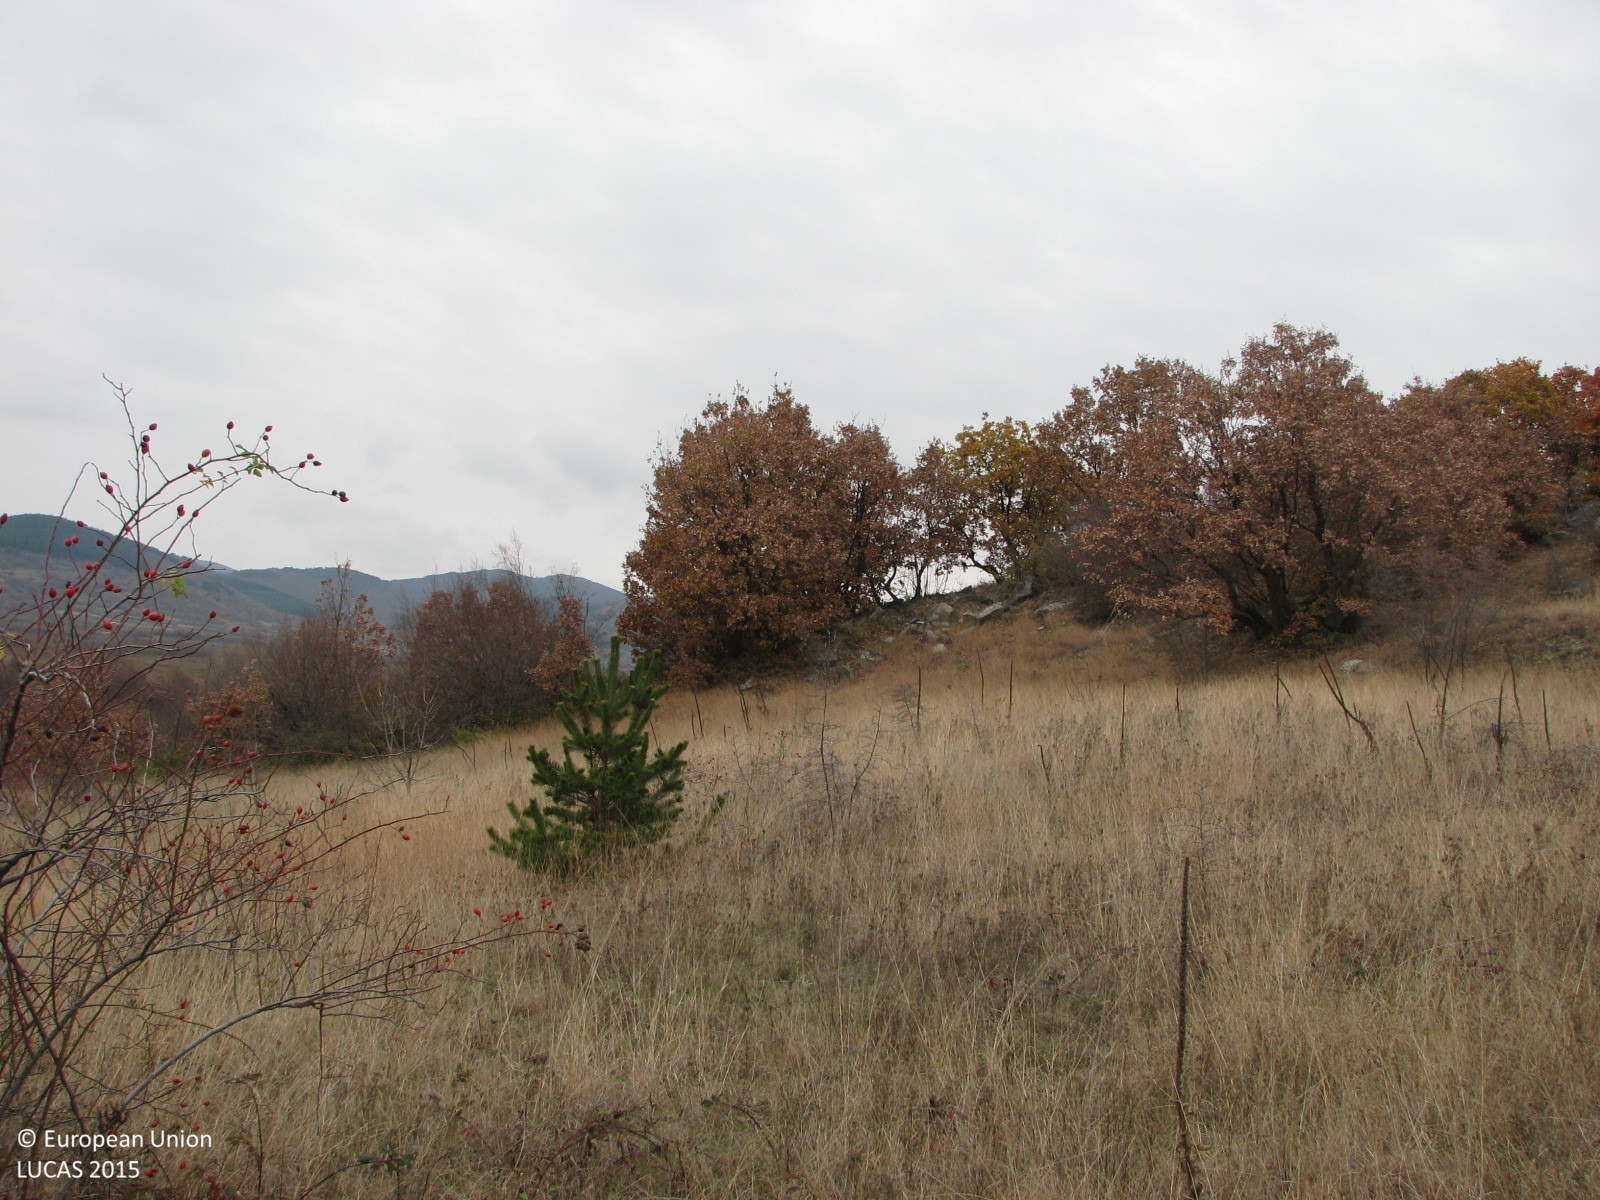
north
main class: Shrubland
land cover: Shrubland with sparse tree cover
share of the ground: 50 - 75 %
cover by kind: shrubs 65 %, herbaceous plants 30 %, broadleaved forest trees 5 %
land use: Semi-natural and natural areas not in use
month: December
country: BG
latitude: 42.2882
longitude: 24.0732
